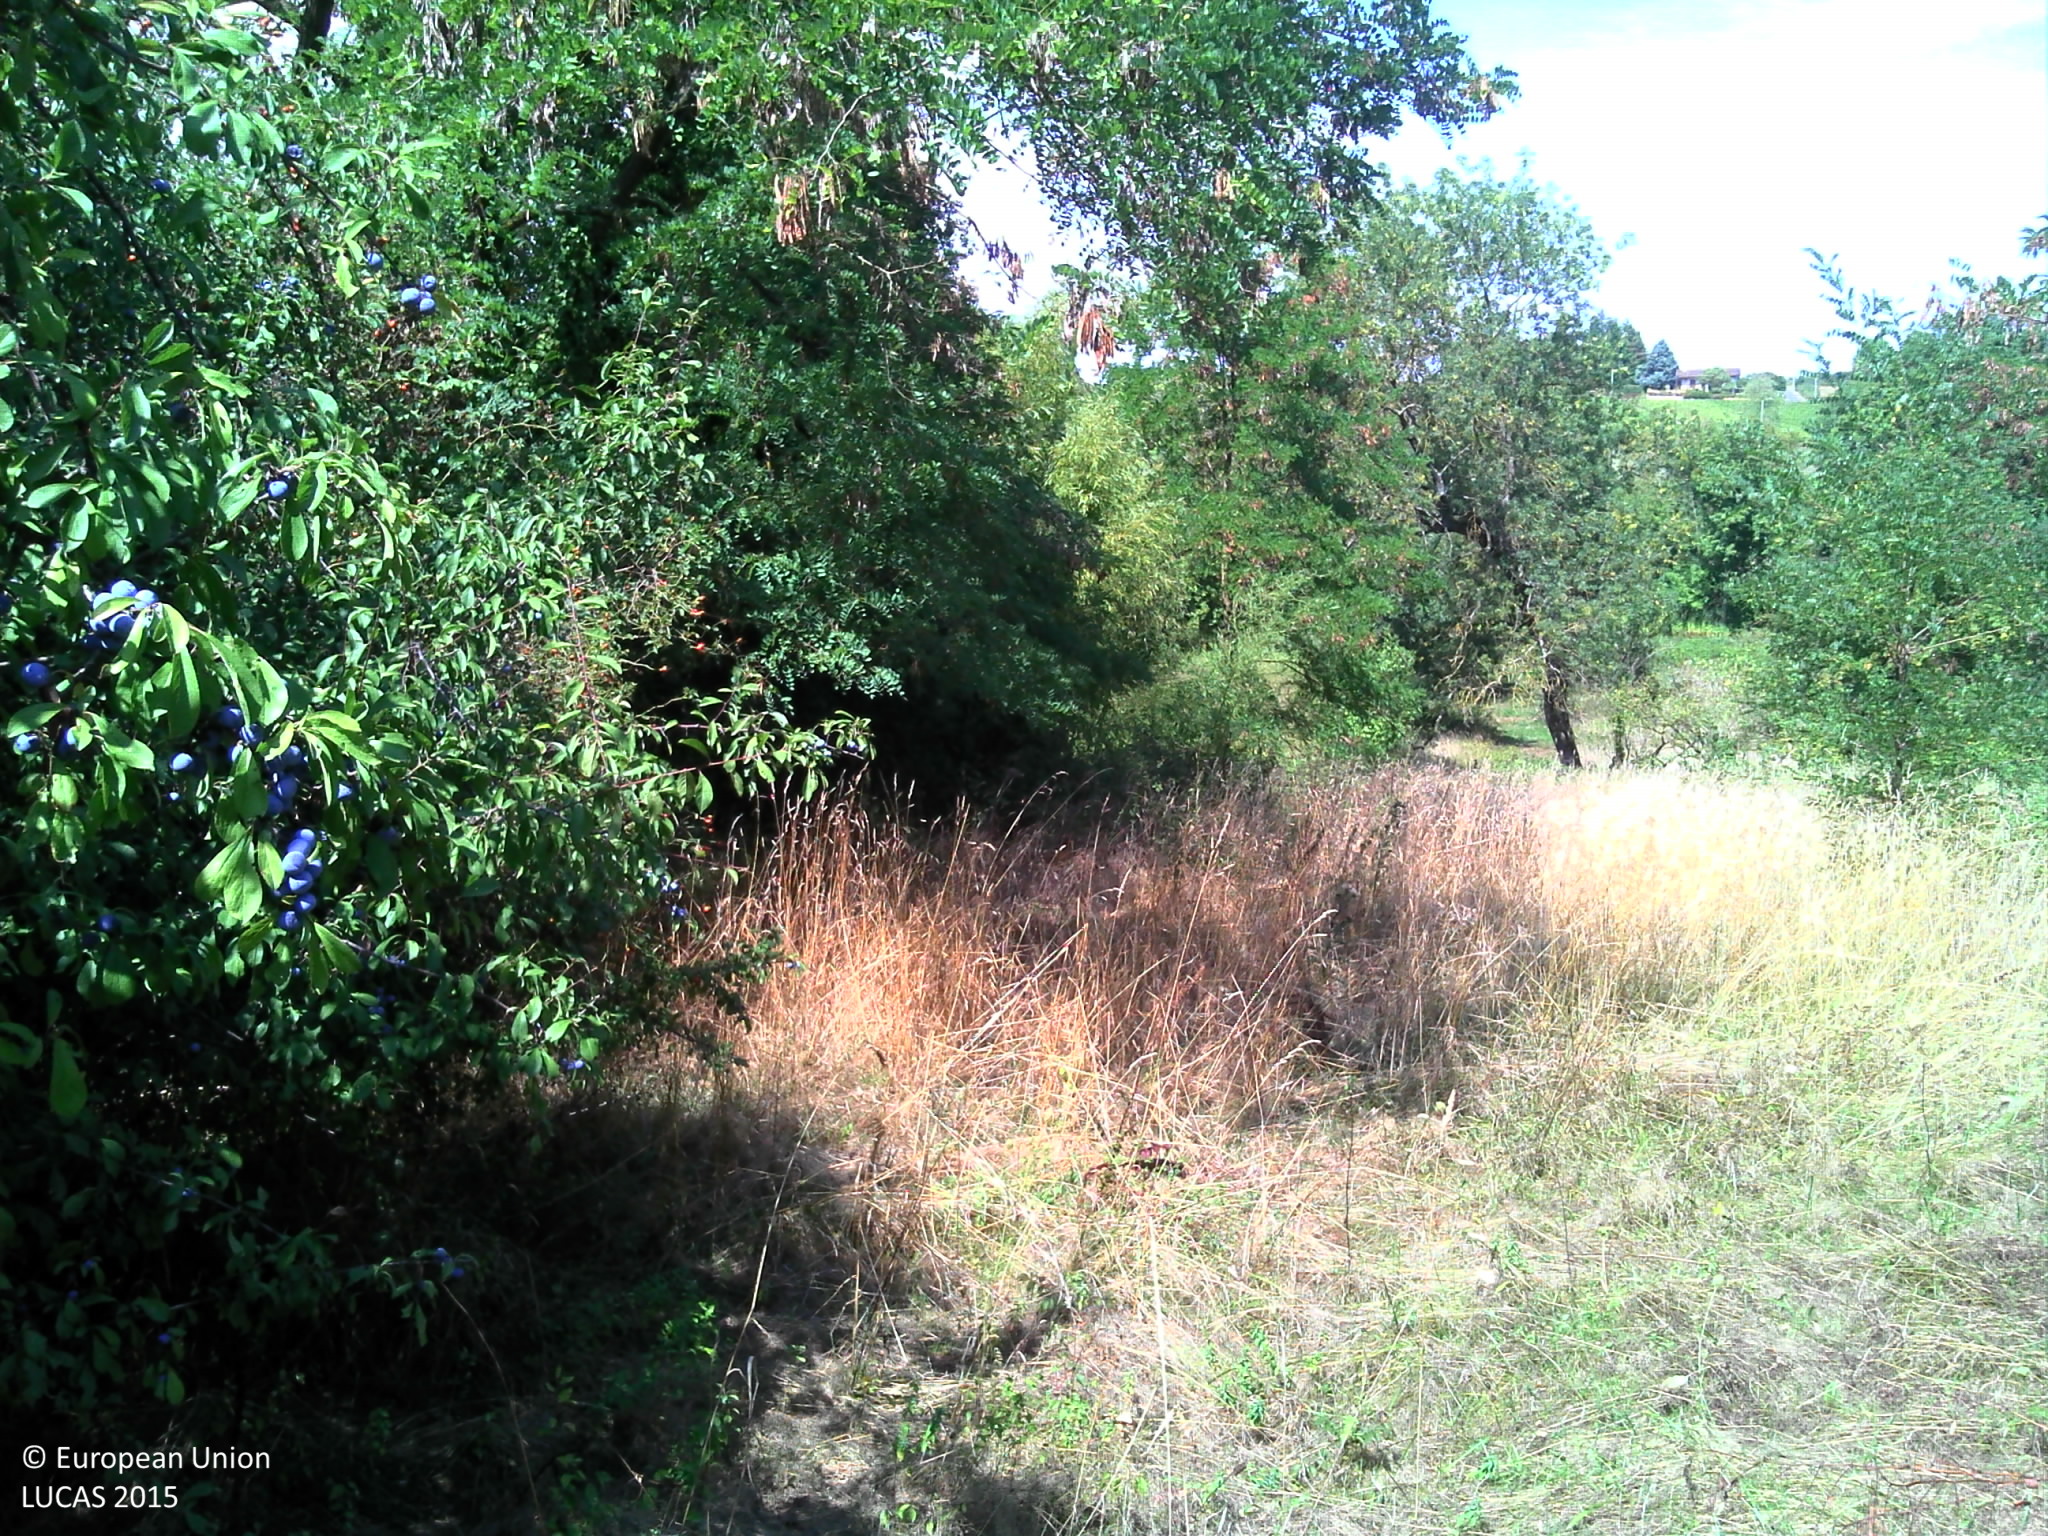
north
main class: Grassland
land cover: Grassland with sparse tree/shrub cover
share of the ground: > 75 %
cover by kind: herbaceous plants 95 %, broadleaved forest trees 5 %
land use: Agriculture (excluding fallow land and kitchen gardens)
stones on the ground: 10 - 25 %
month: August
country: FR
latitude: 45.9838
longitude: 4.6715
